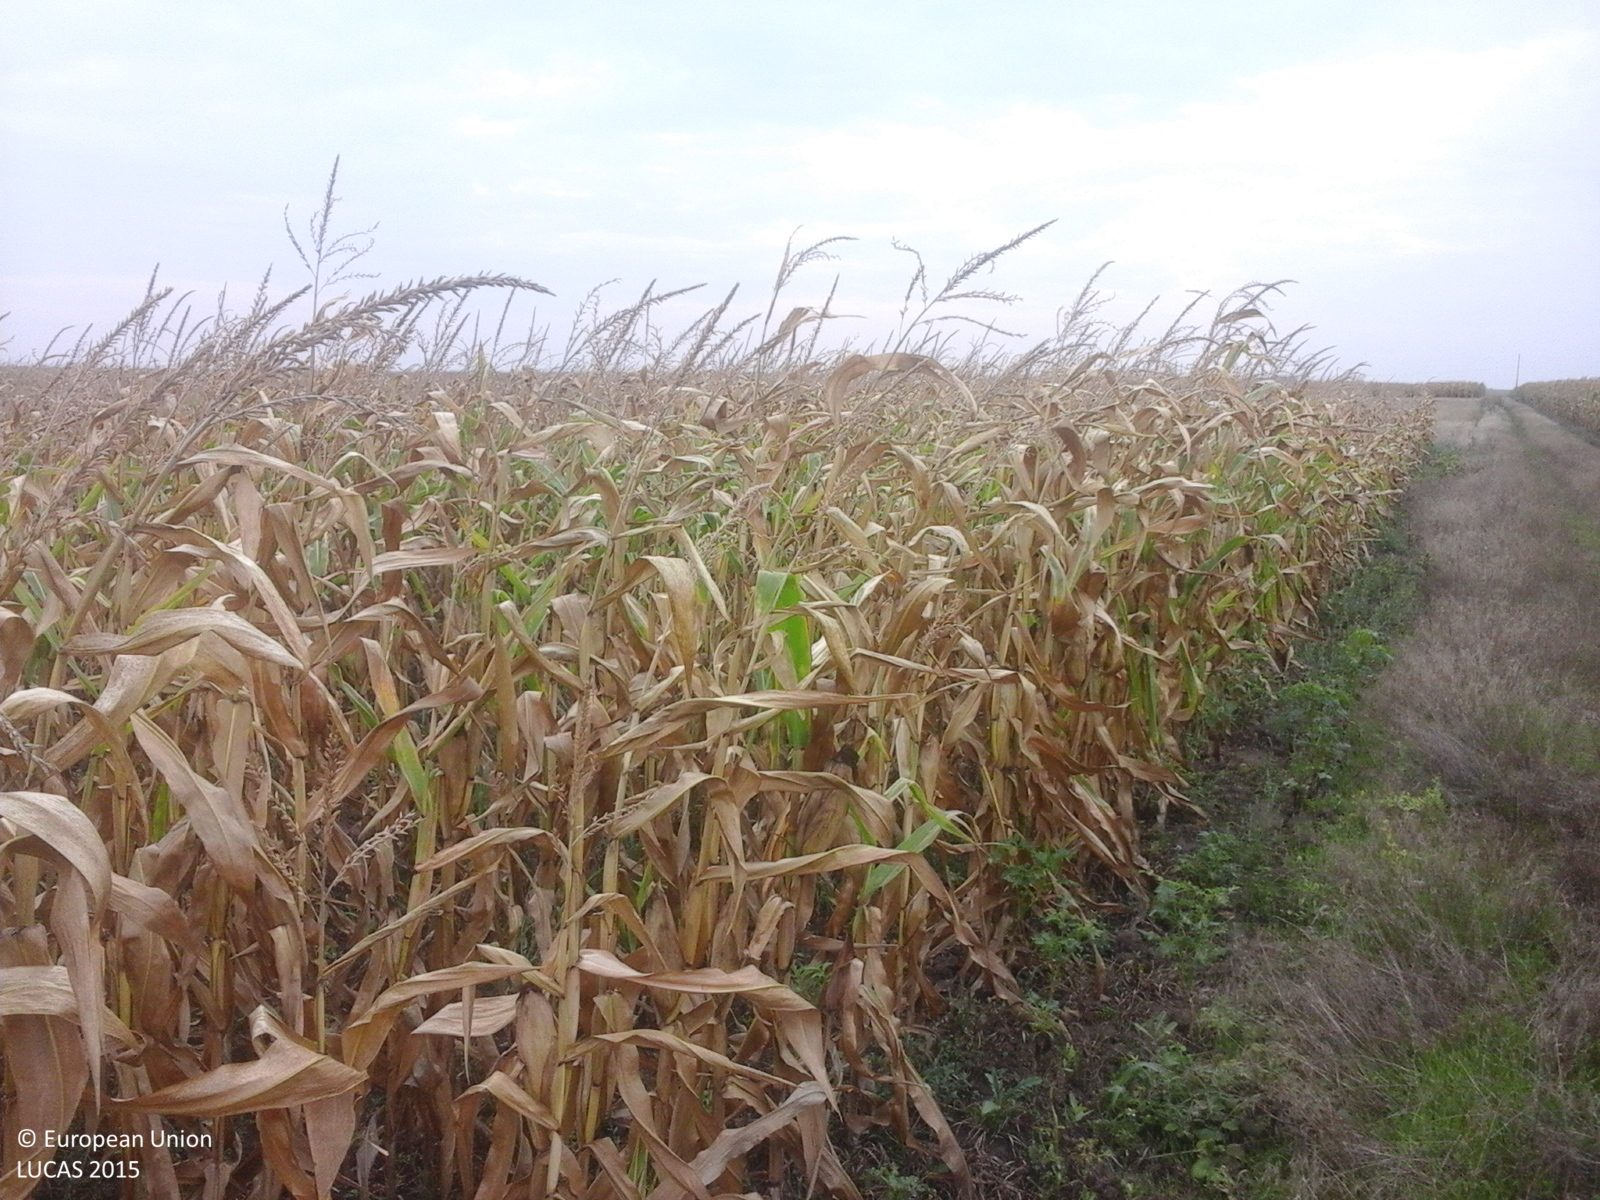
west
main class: Cropland
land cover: Maize
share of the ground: > 75 %
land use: Agriculture (excluding fallow land and kitchen gardens)
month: August
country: RO
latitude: 46.3419
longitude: 21.3781
